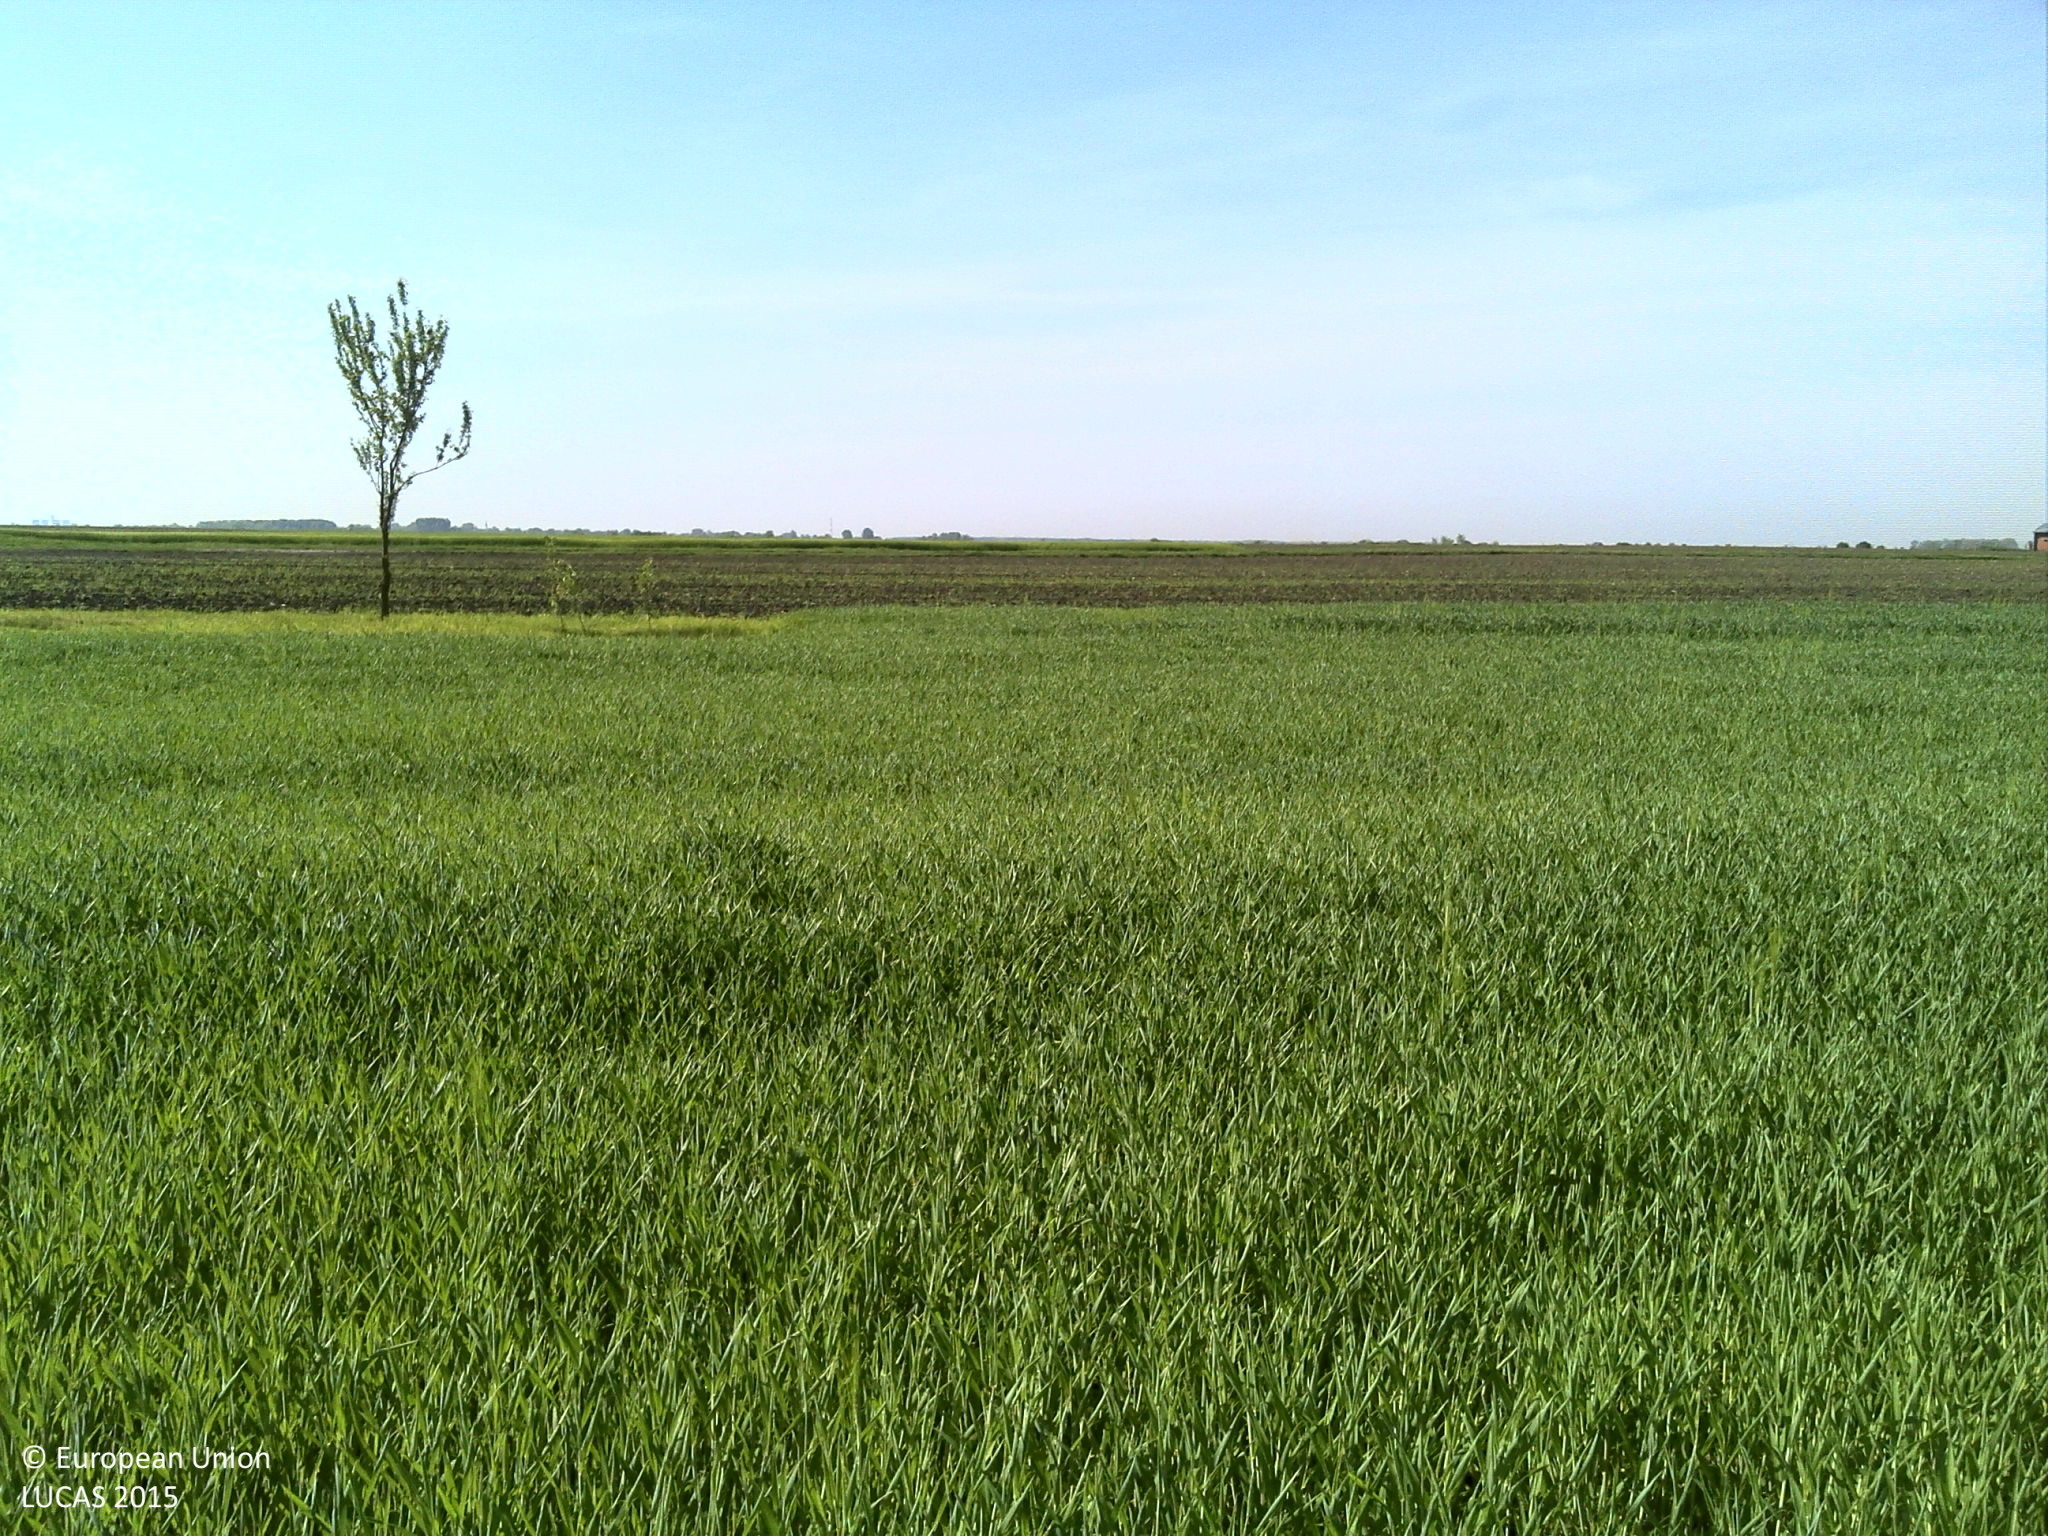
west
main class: Cropland
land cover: Common wheat
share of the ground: > 75 %
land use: Agriculture (excluding fallow land and kitchen gardens)
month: May
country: HR
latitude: 45.4545
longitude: 18.8958
